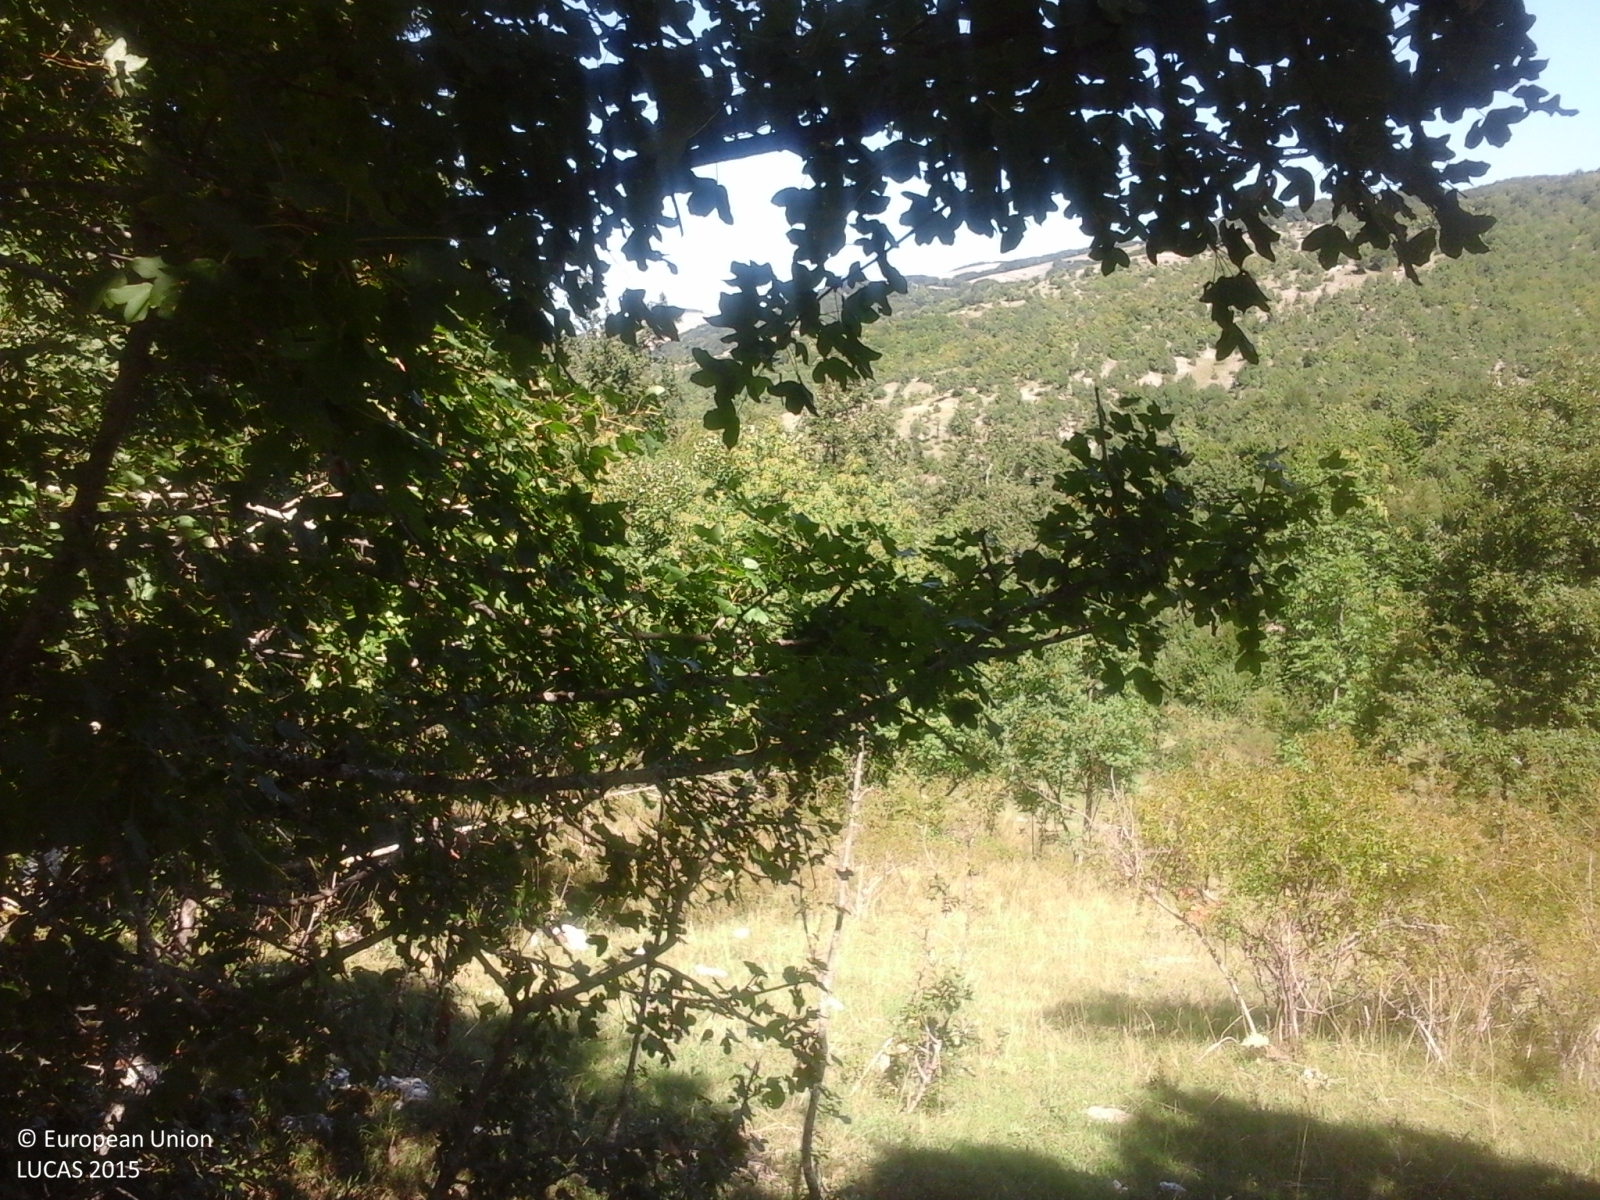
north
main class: Woodland
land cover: Broadleaved woodland
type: thermophilous deciduous forest
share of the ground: 50 - 75 %
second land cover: Grassland without tree/shrub cover
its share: > 75 %
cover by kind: broadleaved forest trees 100 %
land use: Forestry
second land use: Agriculture (excluding fallow land and kitchen gardens)
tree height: < 5 m
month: August
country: IT
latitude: 41.8989
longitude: 13.1828
